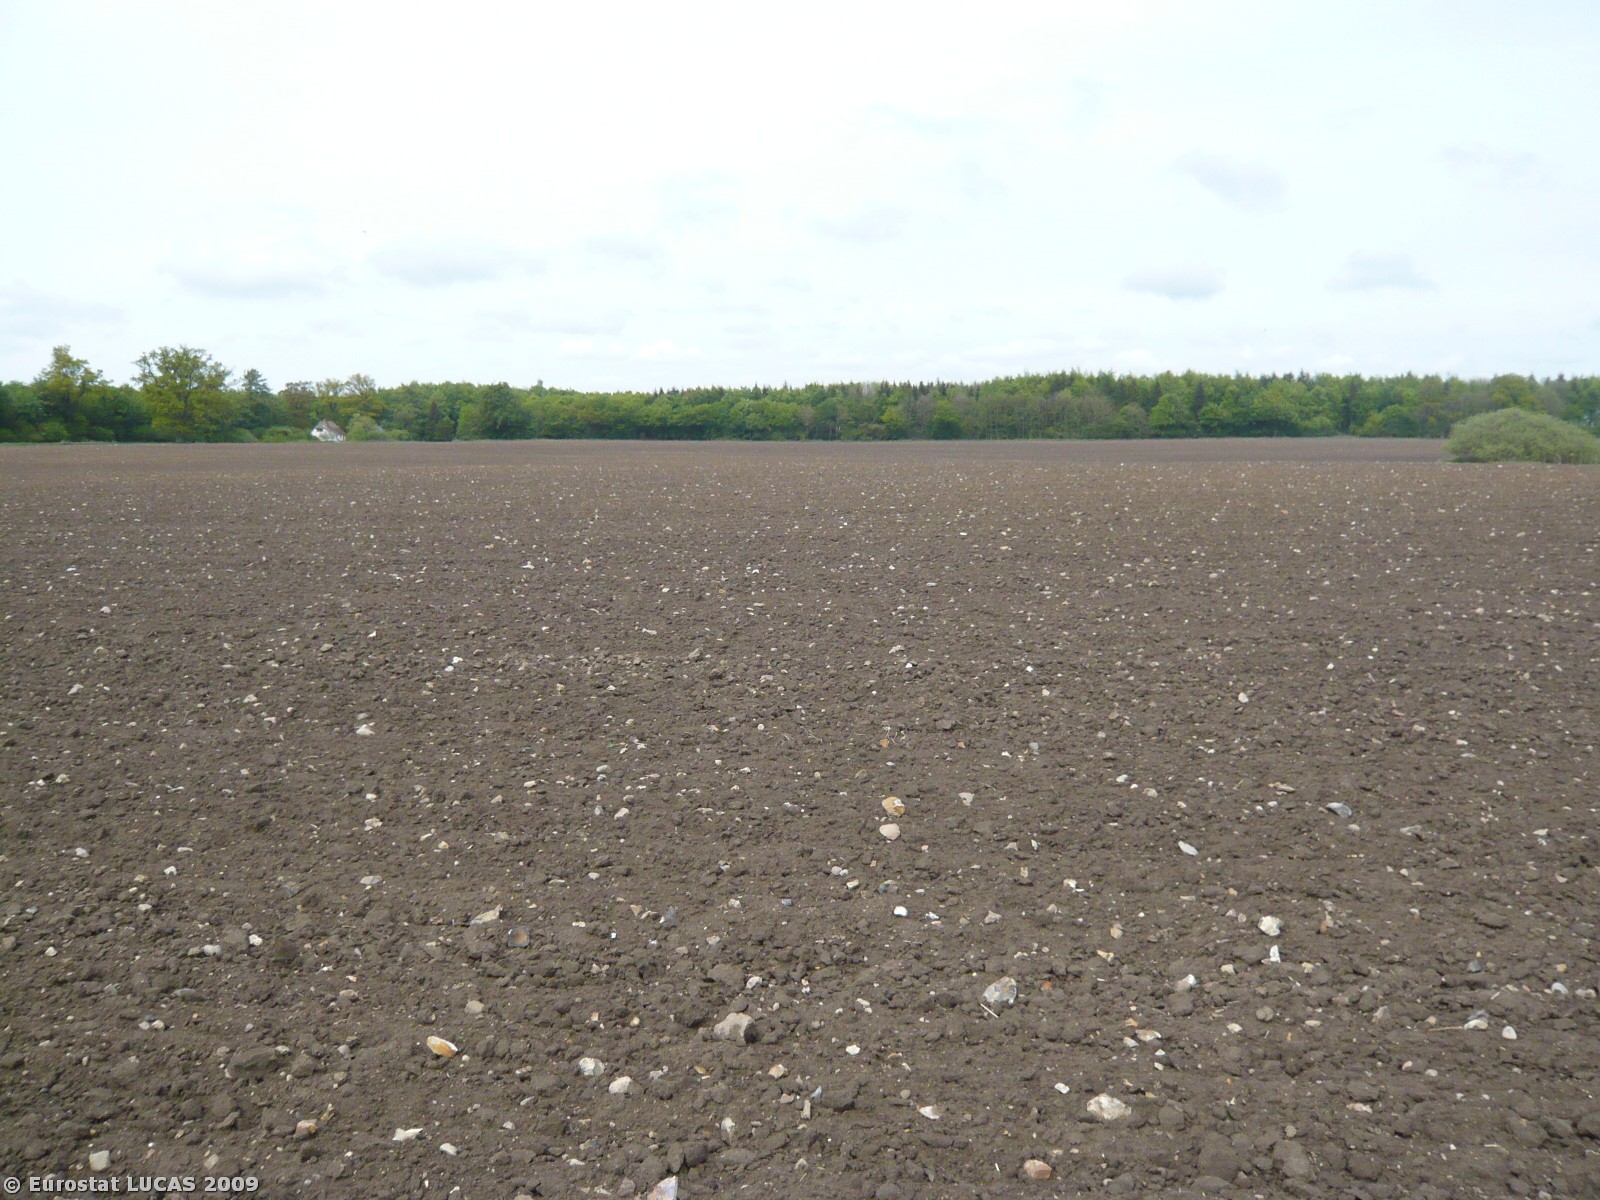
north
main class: Cropland
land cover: Other root crops
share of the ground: < 10 %
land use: Agriculture (excluding fallow land and kitchen gardens)
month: May
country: DK
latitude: 55.2722
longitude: 12.0604
